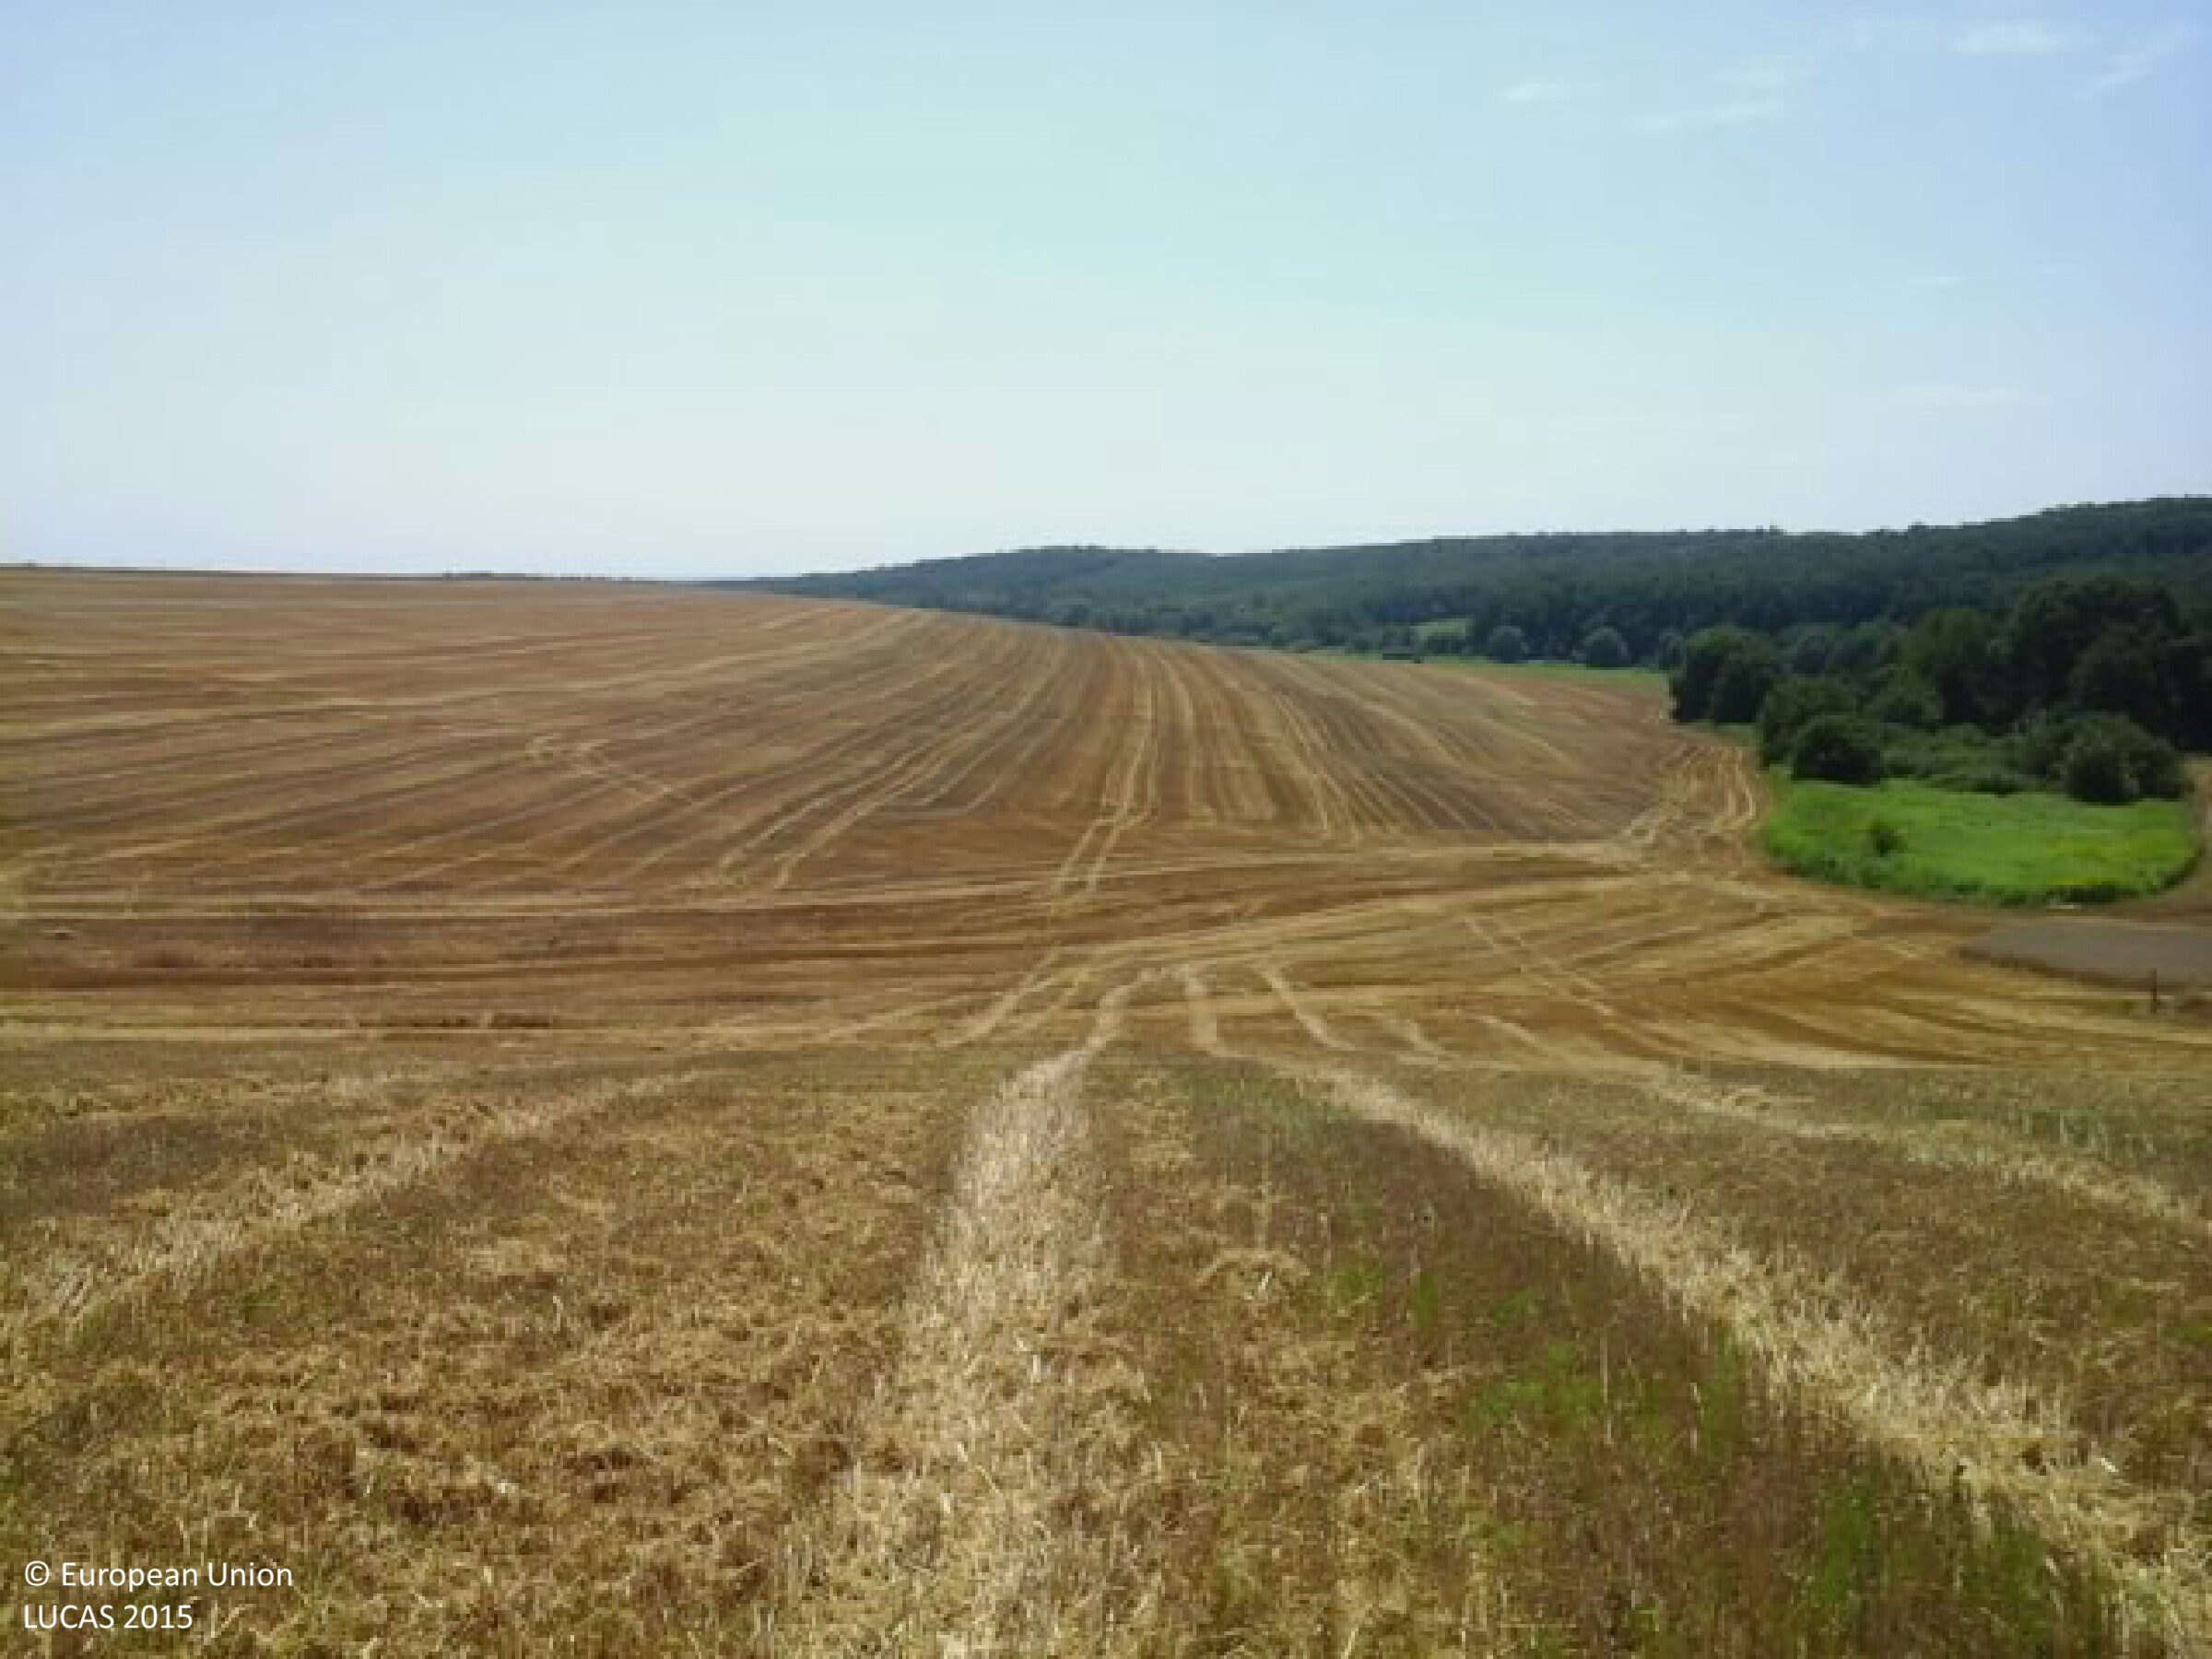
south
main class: Cropland
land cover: Common wheat
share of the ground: > 75 %
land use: Agriculture (excluding fallow land and kitchen gardens)
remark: Harvested field
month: July
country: HU
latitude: 46.2829
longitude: 17.0238
